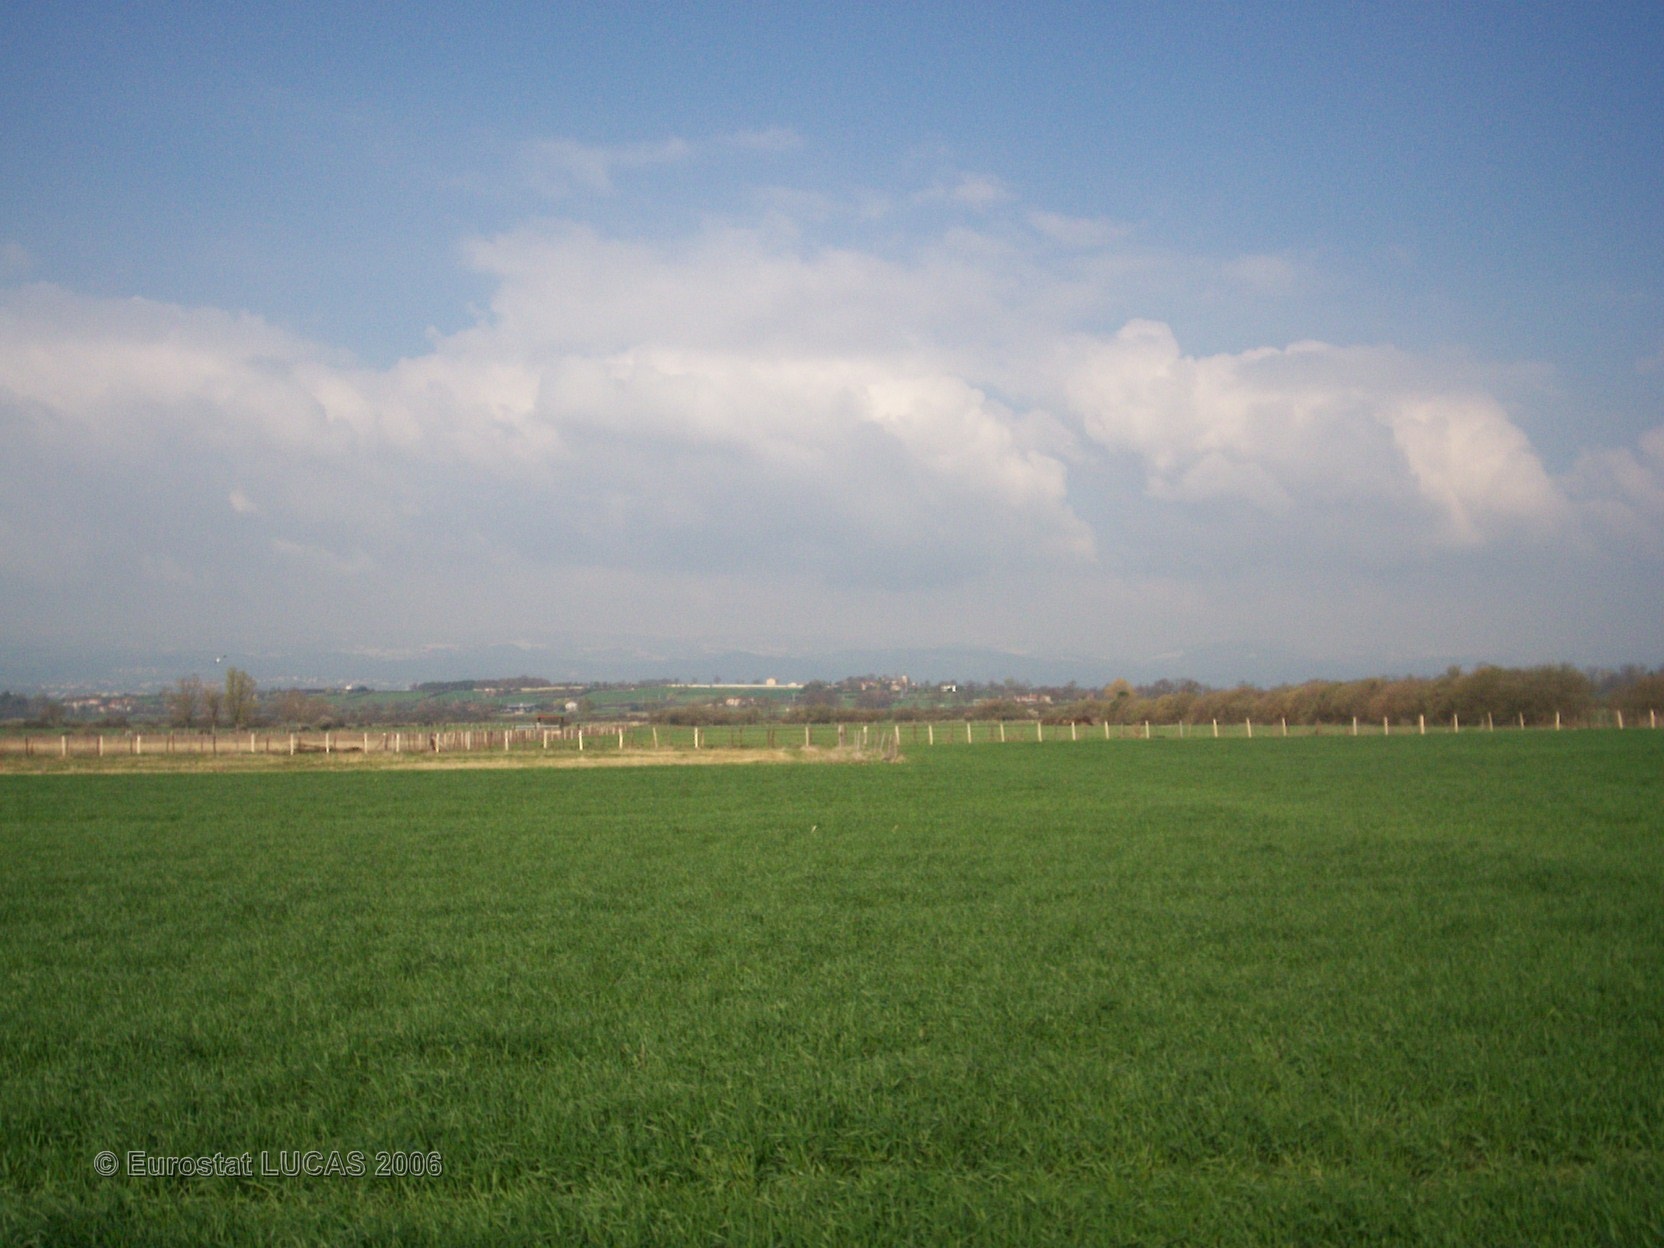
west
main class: Cropland
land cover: Common wheat
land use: Agriculture (excluding fallow land and kitchen gardens)
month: April
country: FR
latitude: 45.5768
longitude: 4.1465
